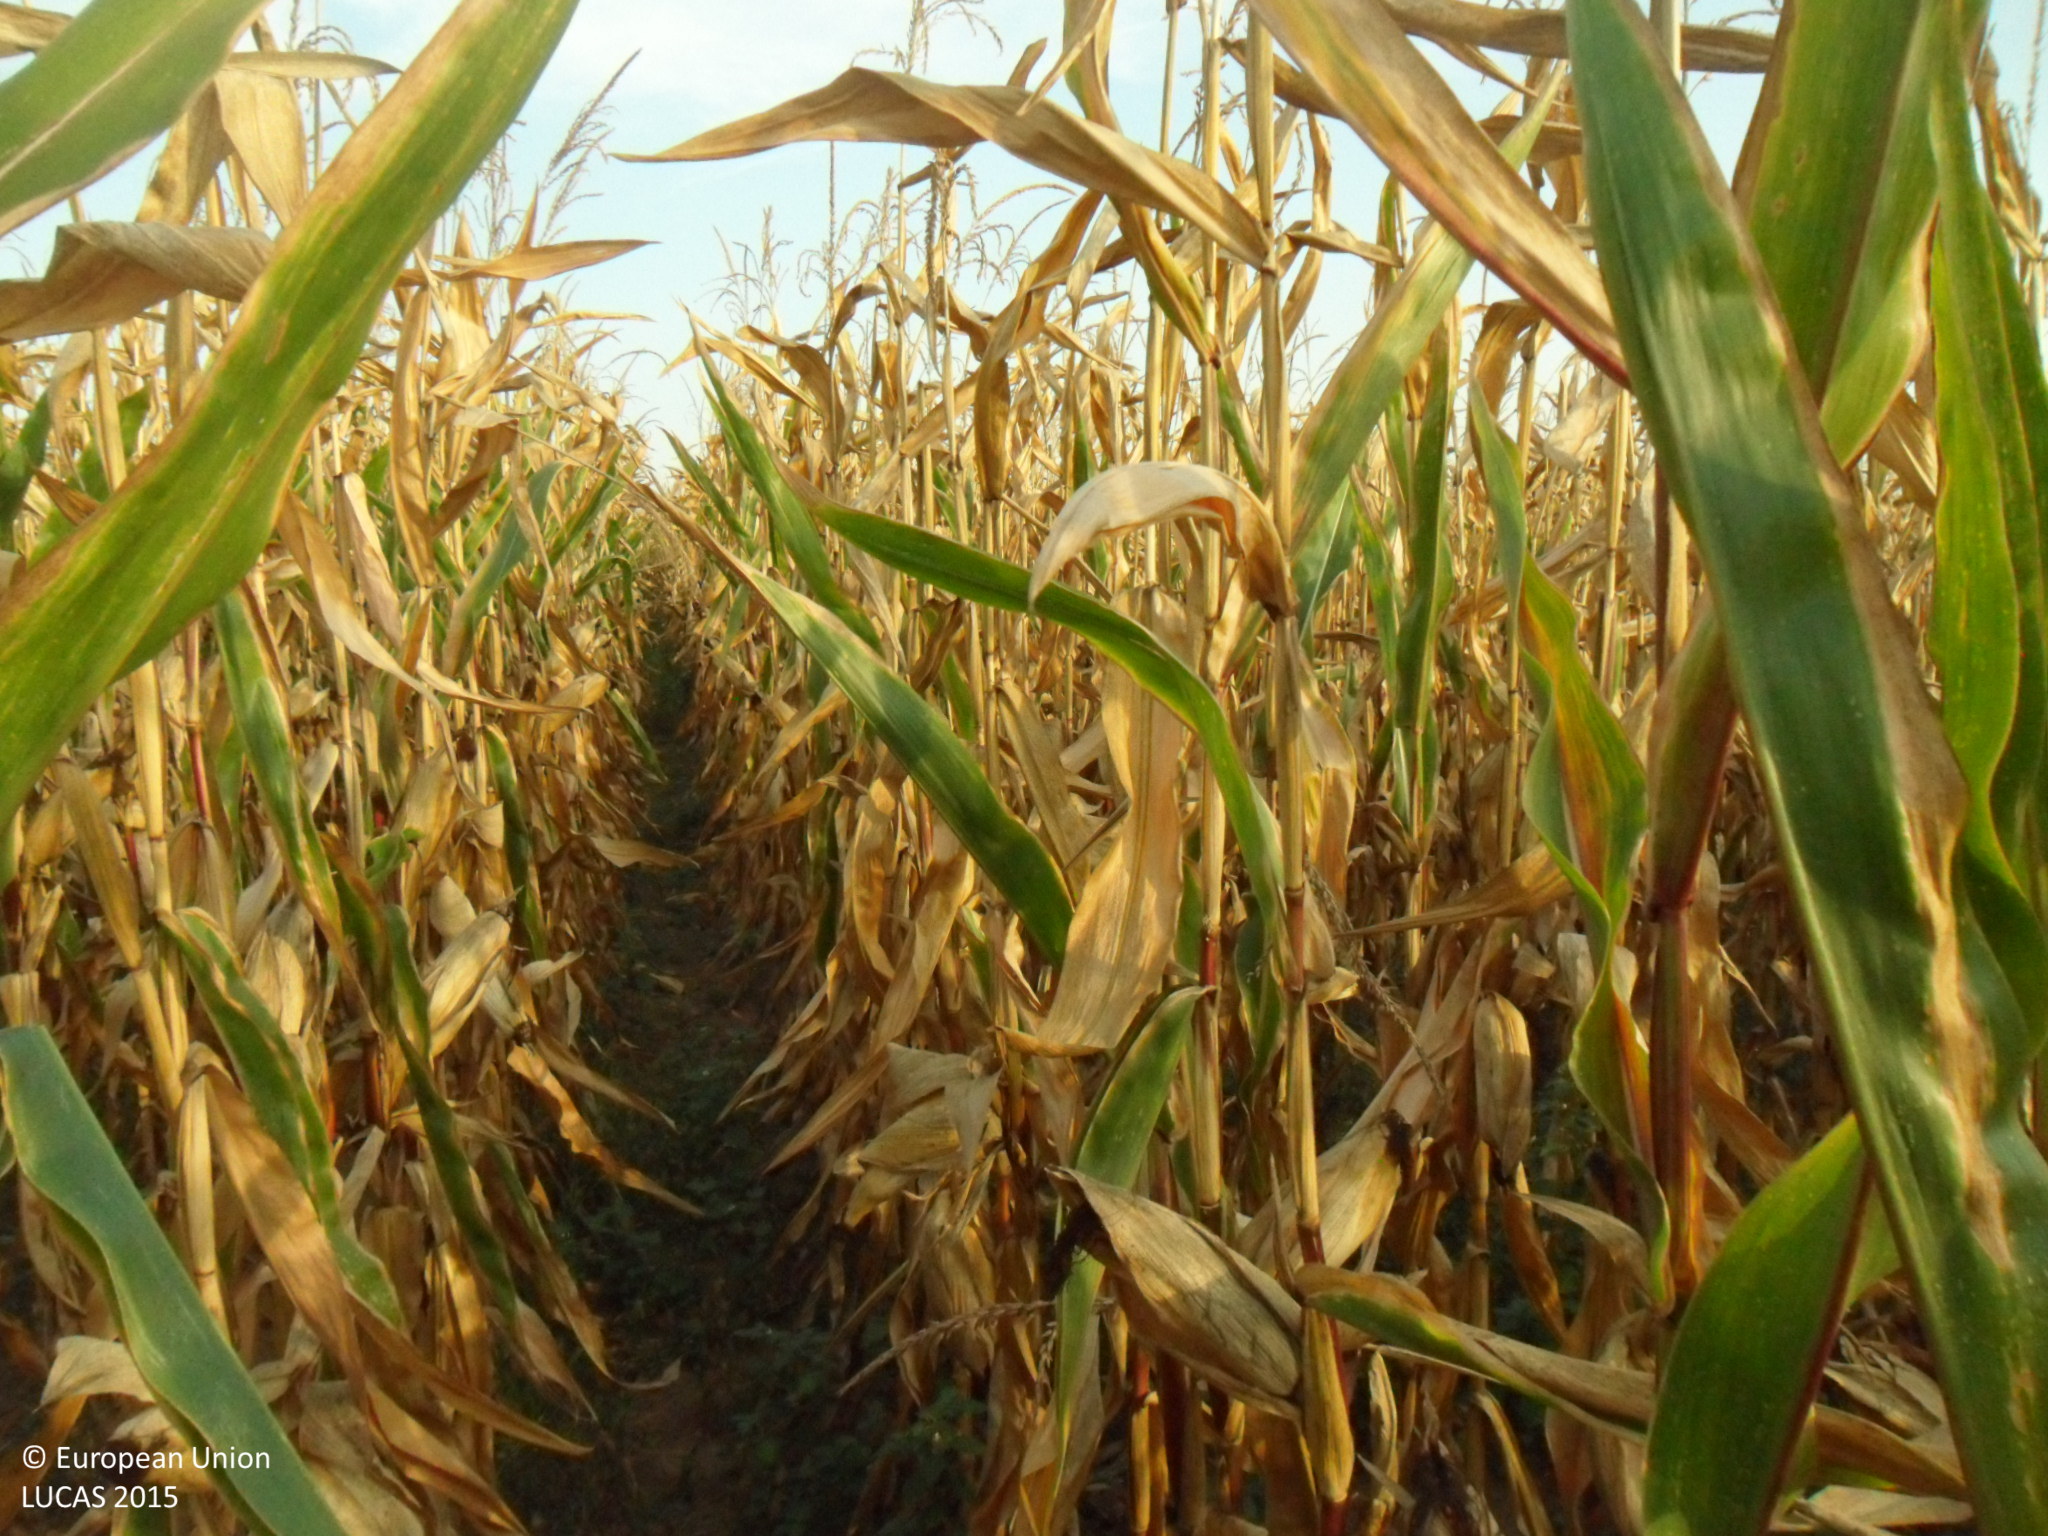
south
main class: Cropland
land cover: Maize
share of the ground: > 75 %
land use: Agriculture (excluding fallow land and kitchen gardens)
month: September
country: BG
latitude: 43.5840
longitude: 26.1856
